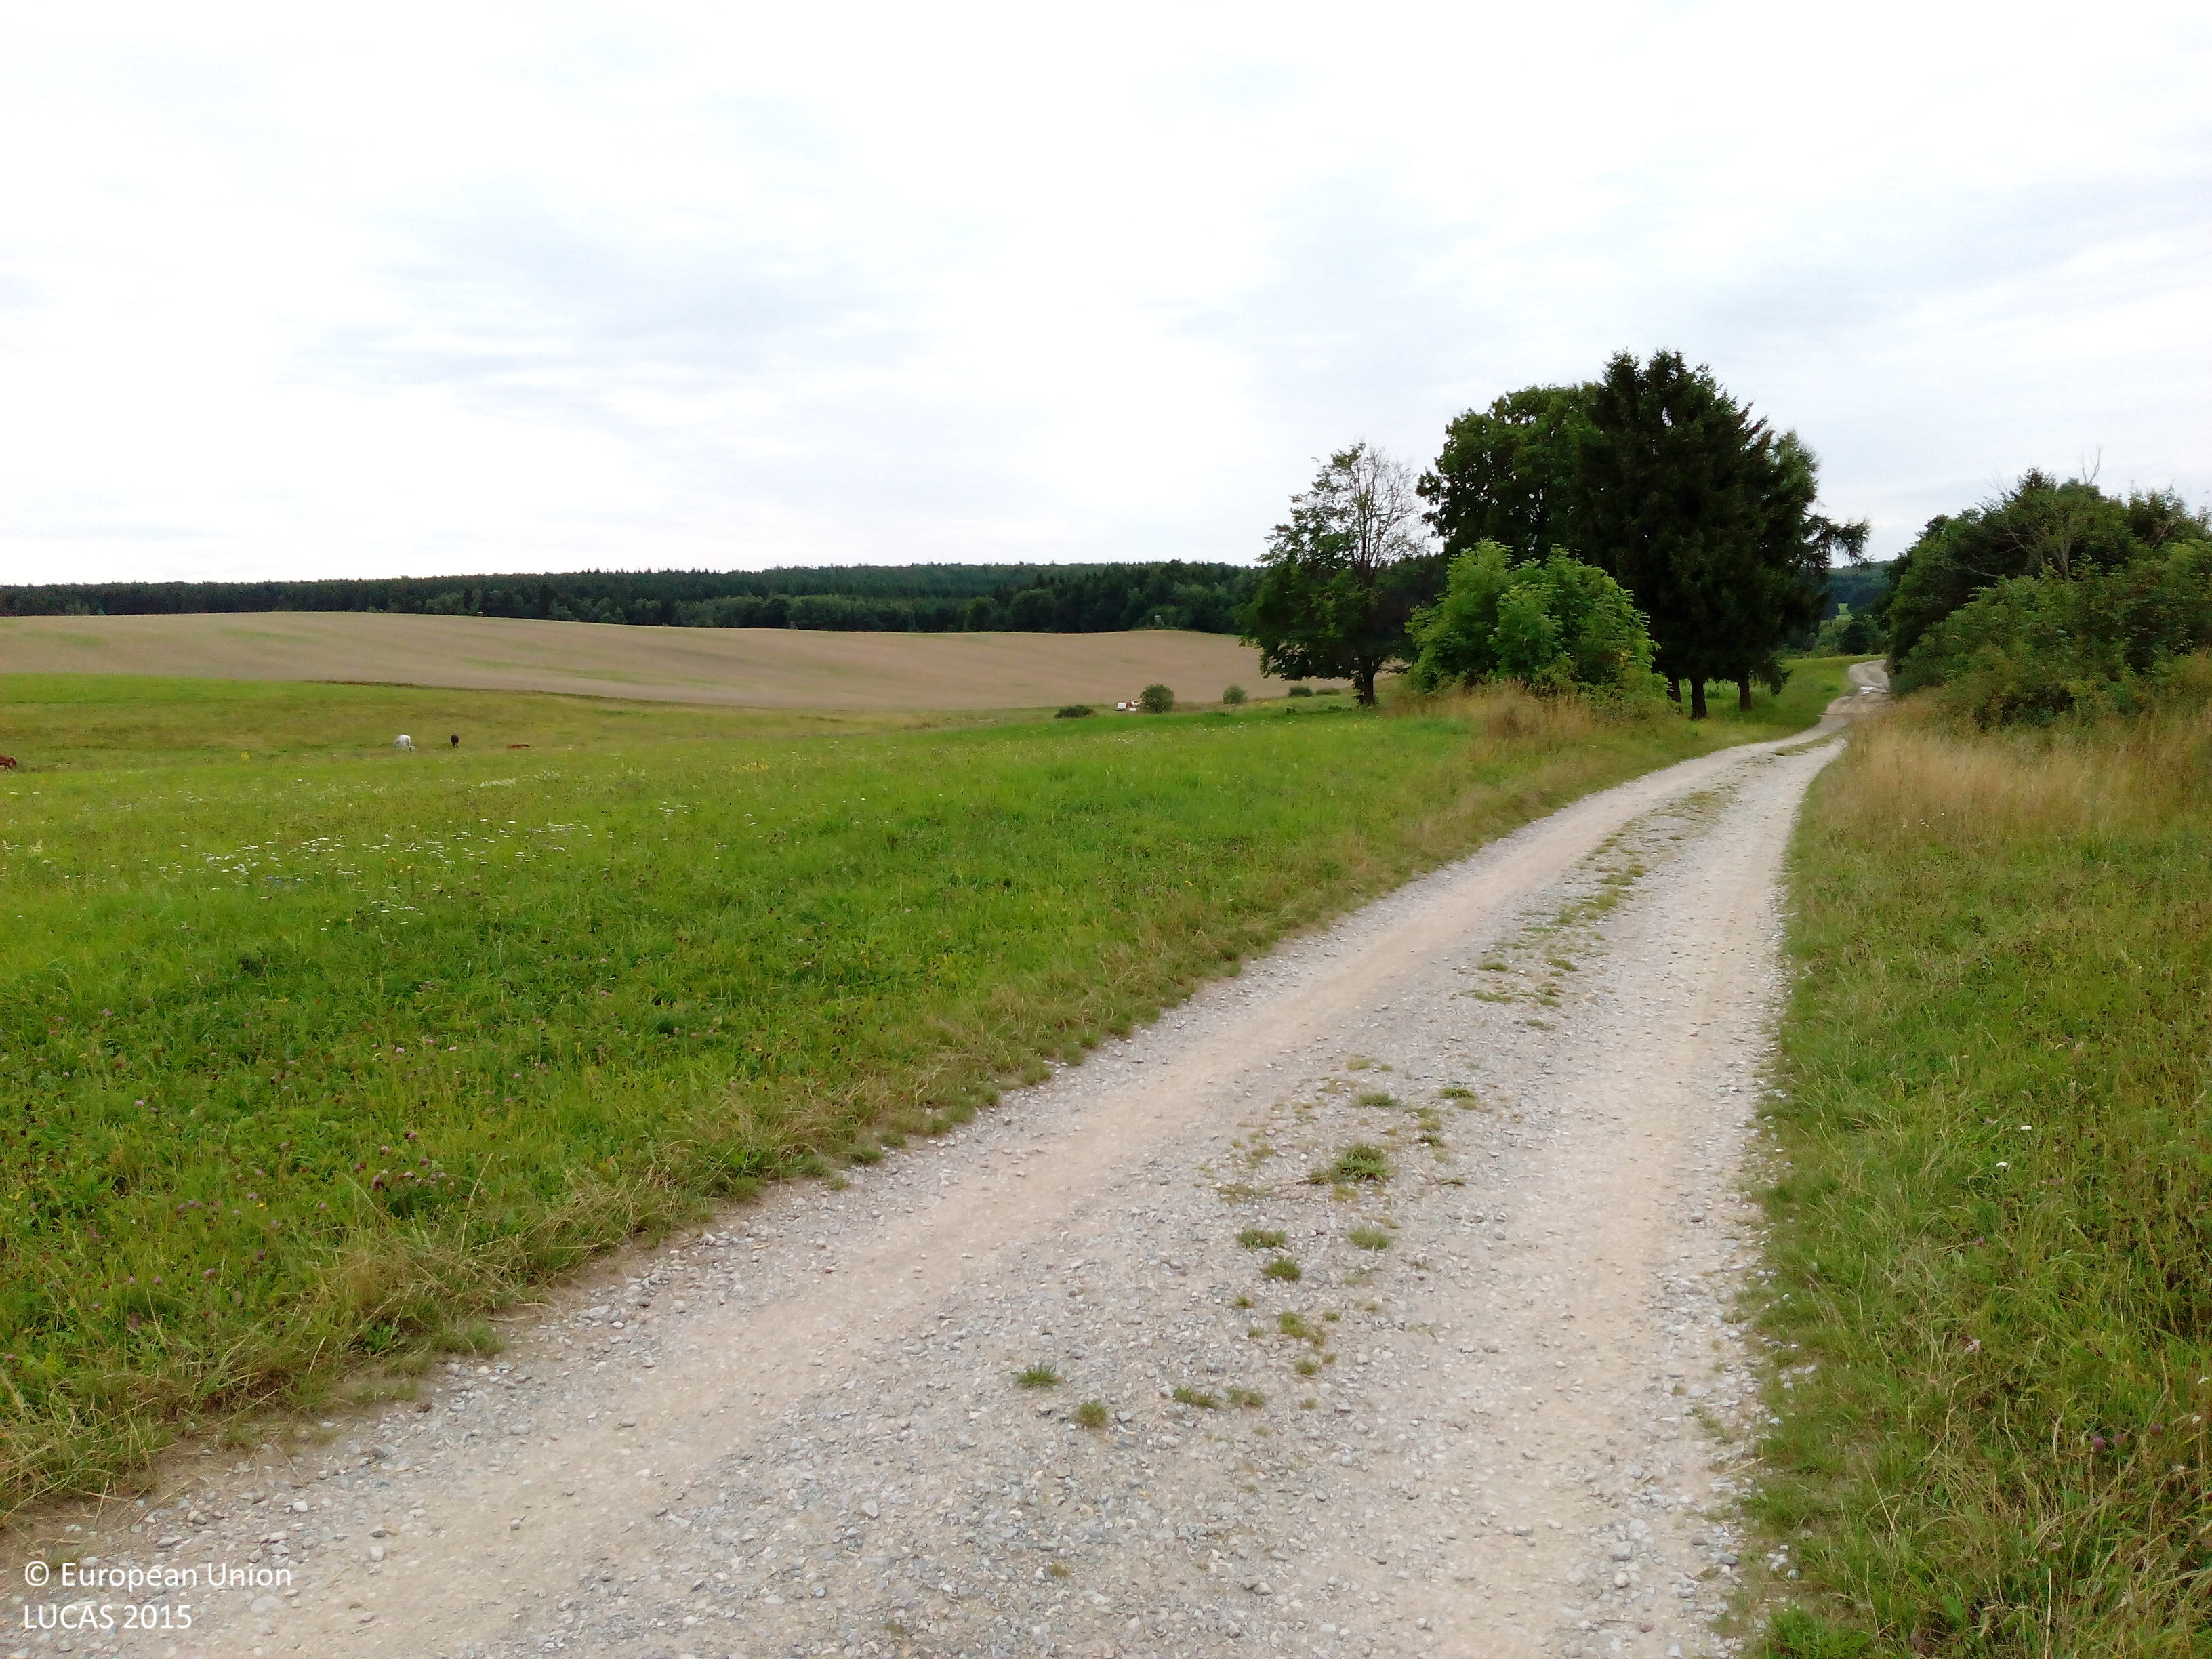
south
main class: Woodland
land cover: Other mixed woodland
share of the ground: 50 - 75 %
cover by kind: coniferous forest trees 40 %, herbaceous plants 30 %, broadleaved forest trees 25 %, shrubs 5 %
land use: Forestry
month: August
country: DE
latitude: 51.6724
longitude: 10.9686
